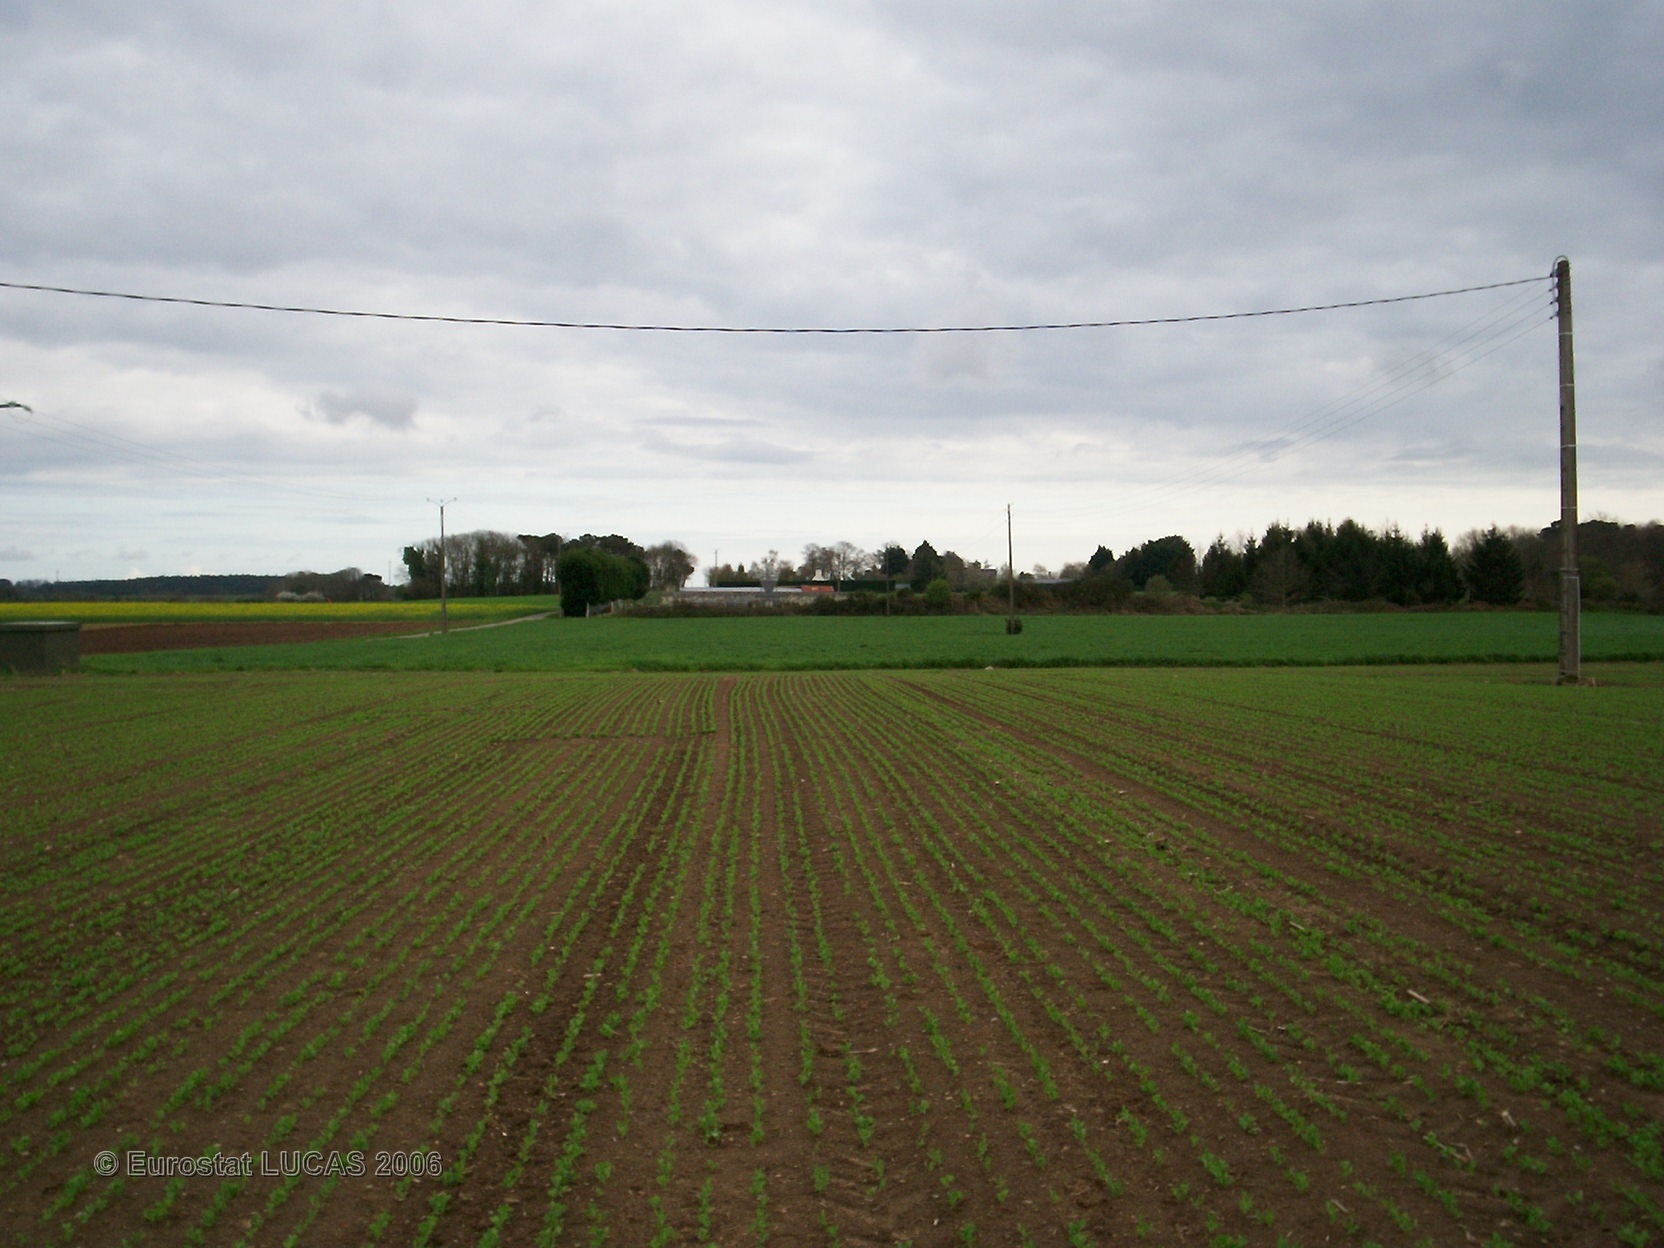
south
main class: Cropland
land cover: Dry pulses
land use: Agriculture (excluding fallow land and kitchen gardens)
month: April
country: FR
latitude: 47.8229
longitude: -3.5267
